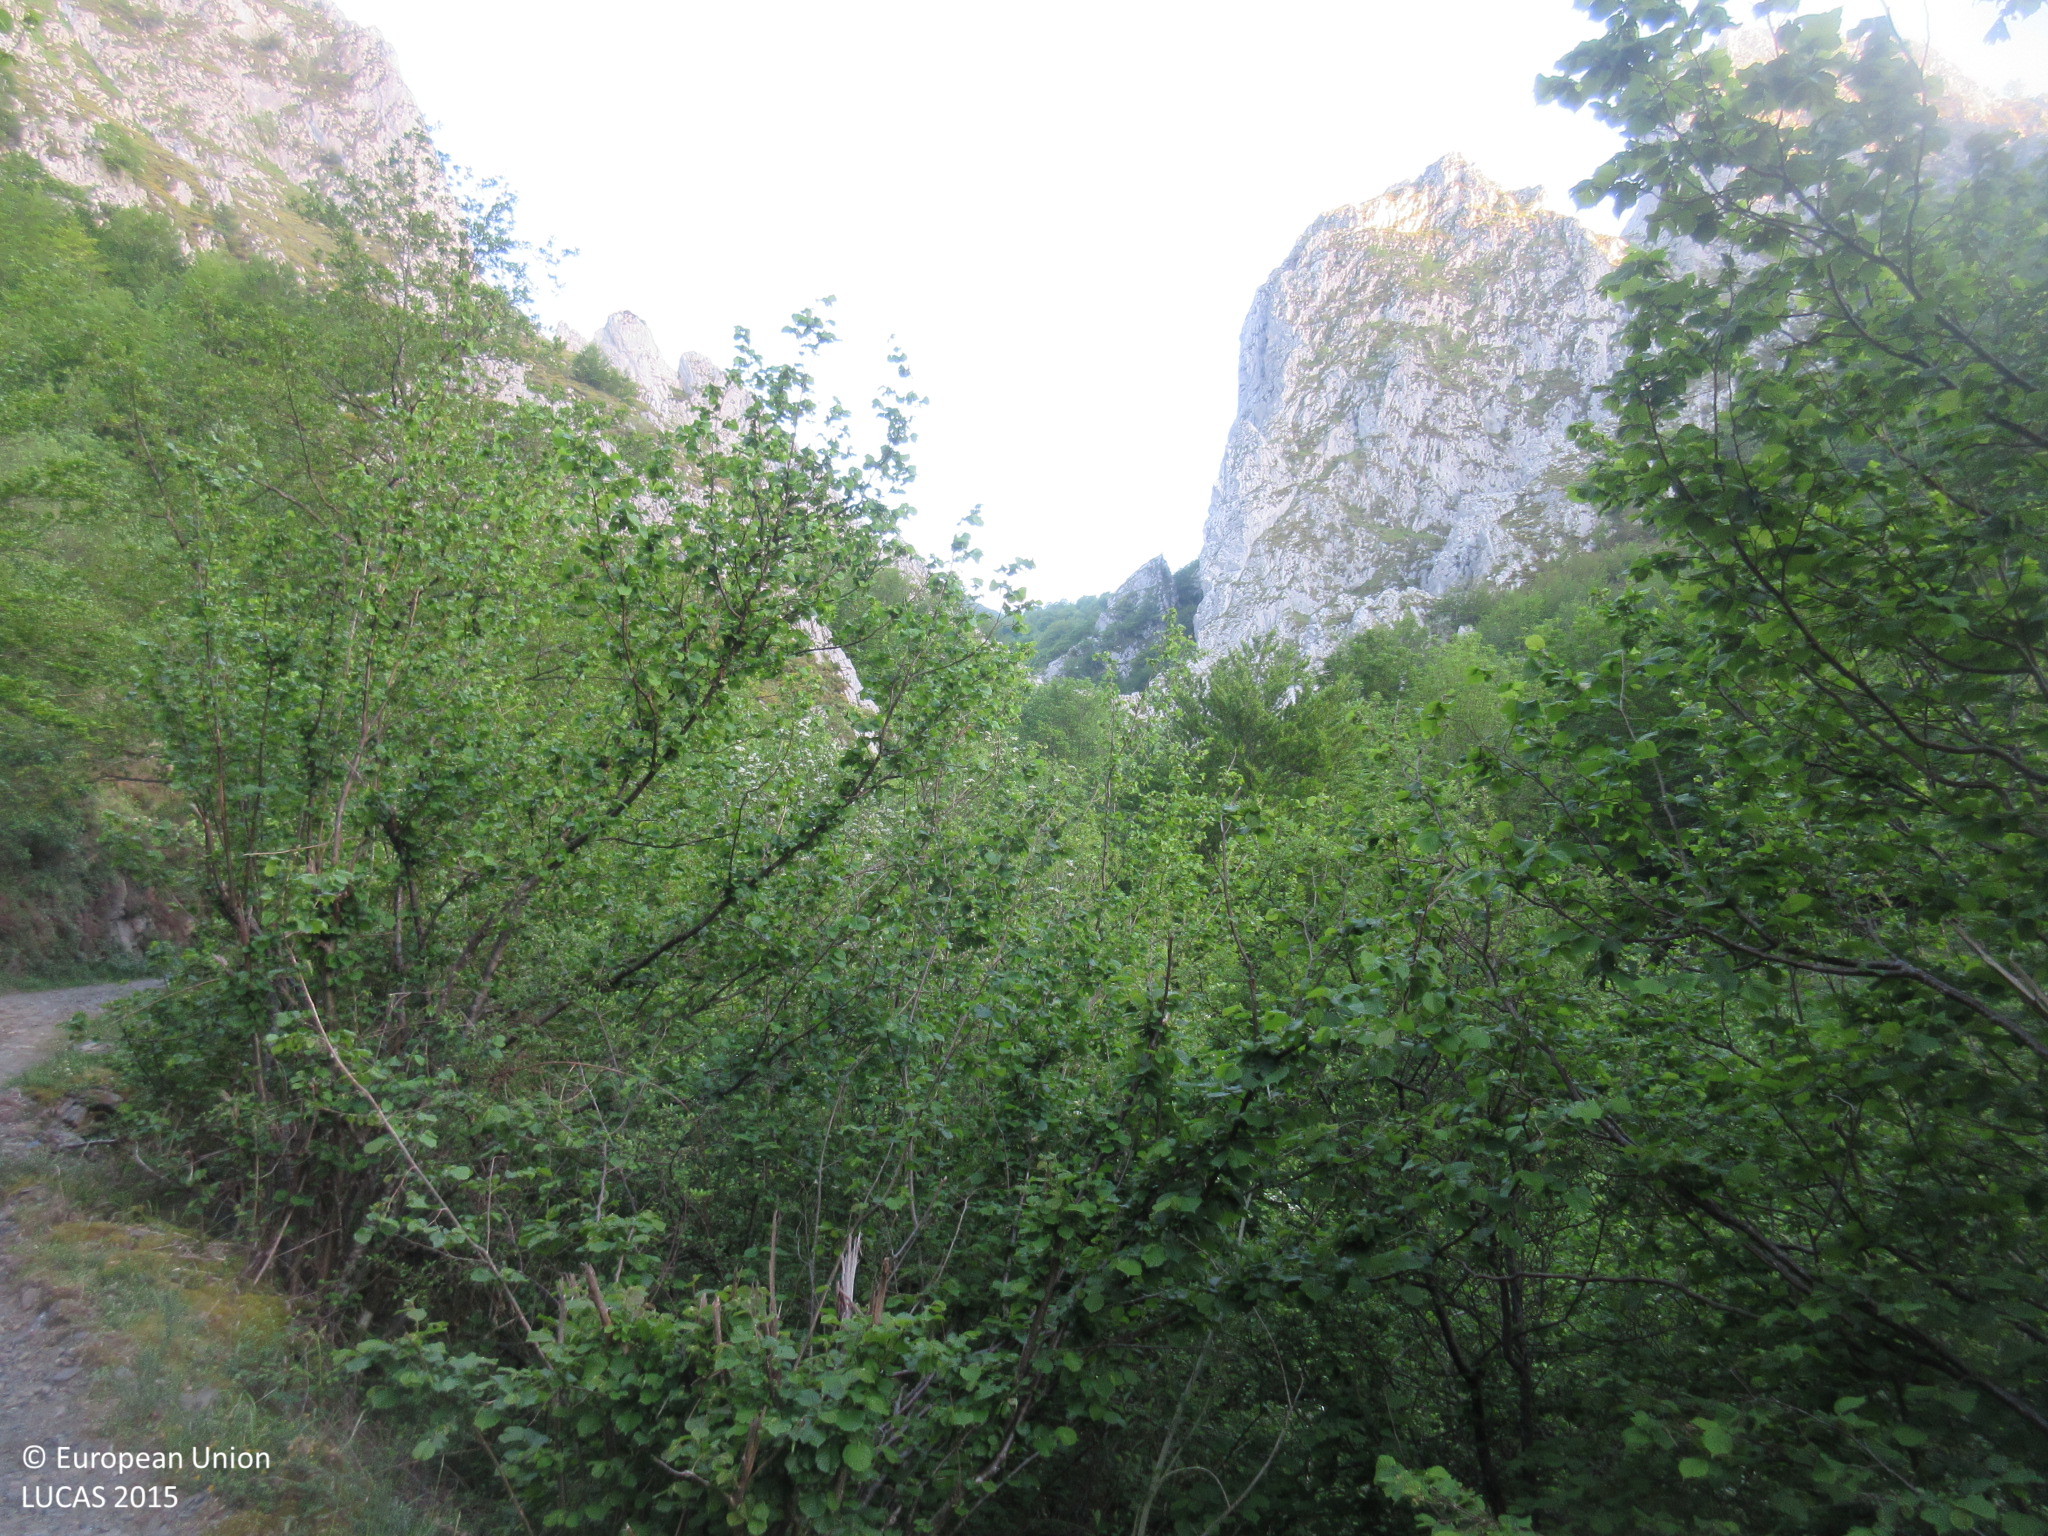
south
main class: Shrubland
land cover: Shrubland with sparse tree cover
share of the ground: > 75 %
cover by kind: shrubs 95 %, broadleaved forest trees 5 %
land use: Semi-natural and natural areas not in use
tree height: > 5 m
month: May
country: ES
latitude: 43.0830
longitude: -5.5174
